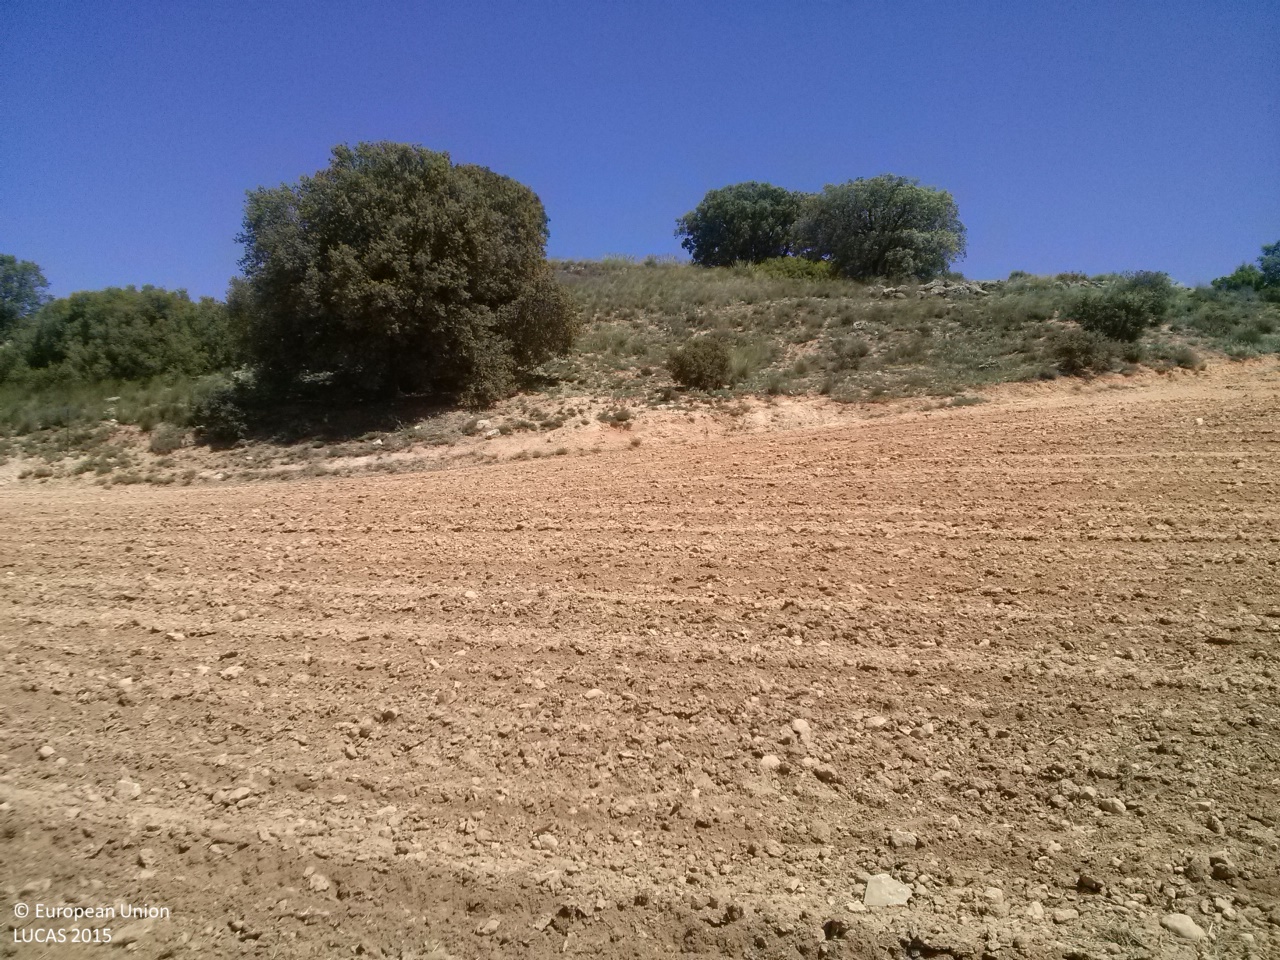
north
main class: Cropland
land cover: Sunflower
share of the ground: < 10 %
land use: Agriculture (excluding fallow land and kitchen gardens)
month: May
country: ES
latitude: 39.7429
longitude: -2.7492
